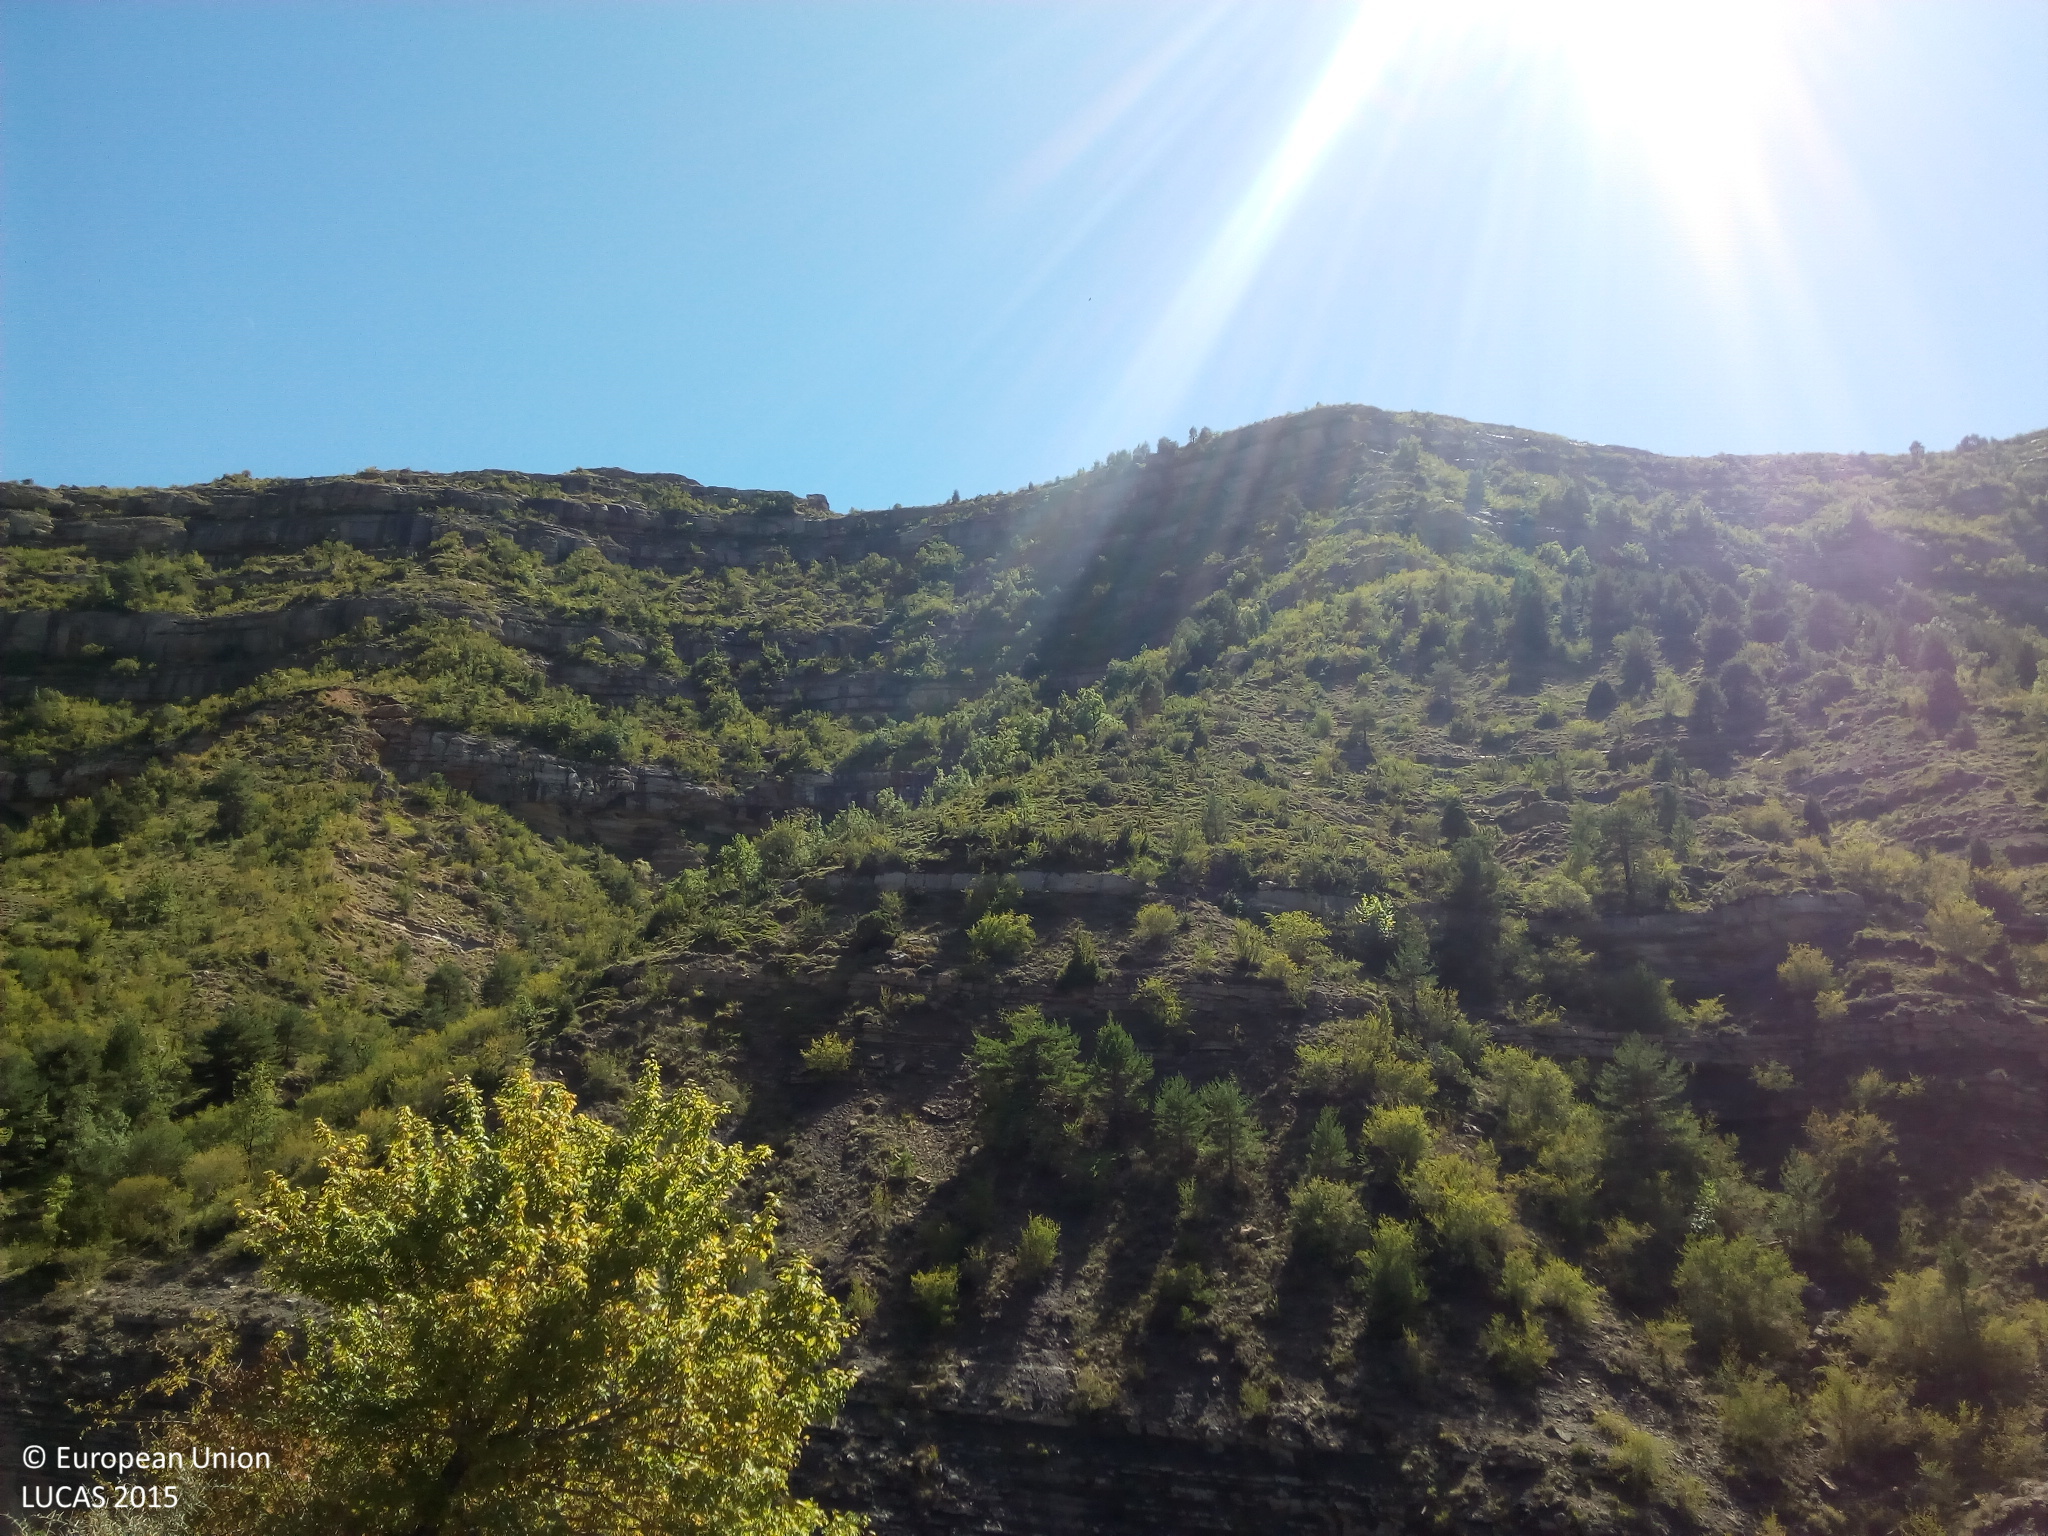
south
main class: Woodland
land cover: Pine dominated mixed woodland
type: coniferous forest of the mediterranean region
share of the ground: > 75 %
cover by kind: consolidated bare surface 35 %, shrubs 30 %, herbaceous plants 20 %, coniferous forest trees 10 %, broadleaved forest trees 5 %
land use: Semi-natural and natural areas not in use
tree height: < 5 m
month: September
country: ES
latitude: 42.3073
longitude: 0.6048
